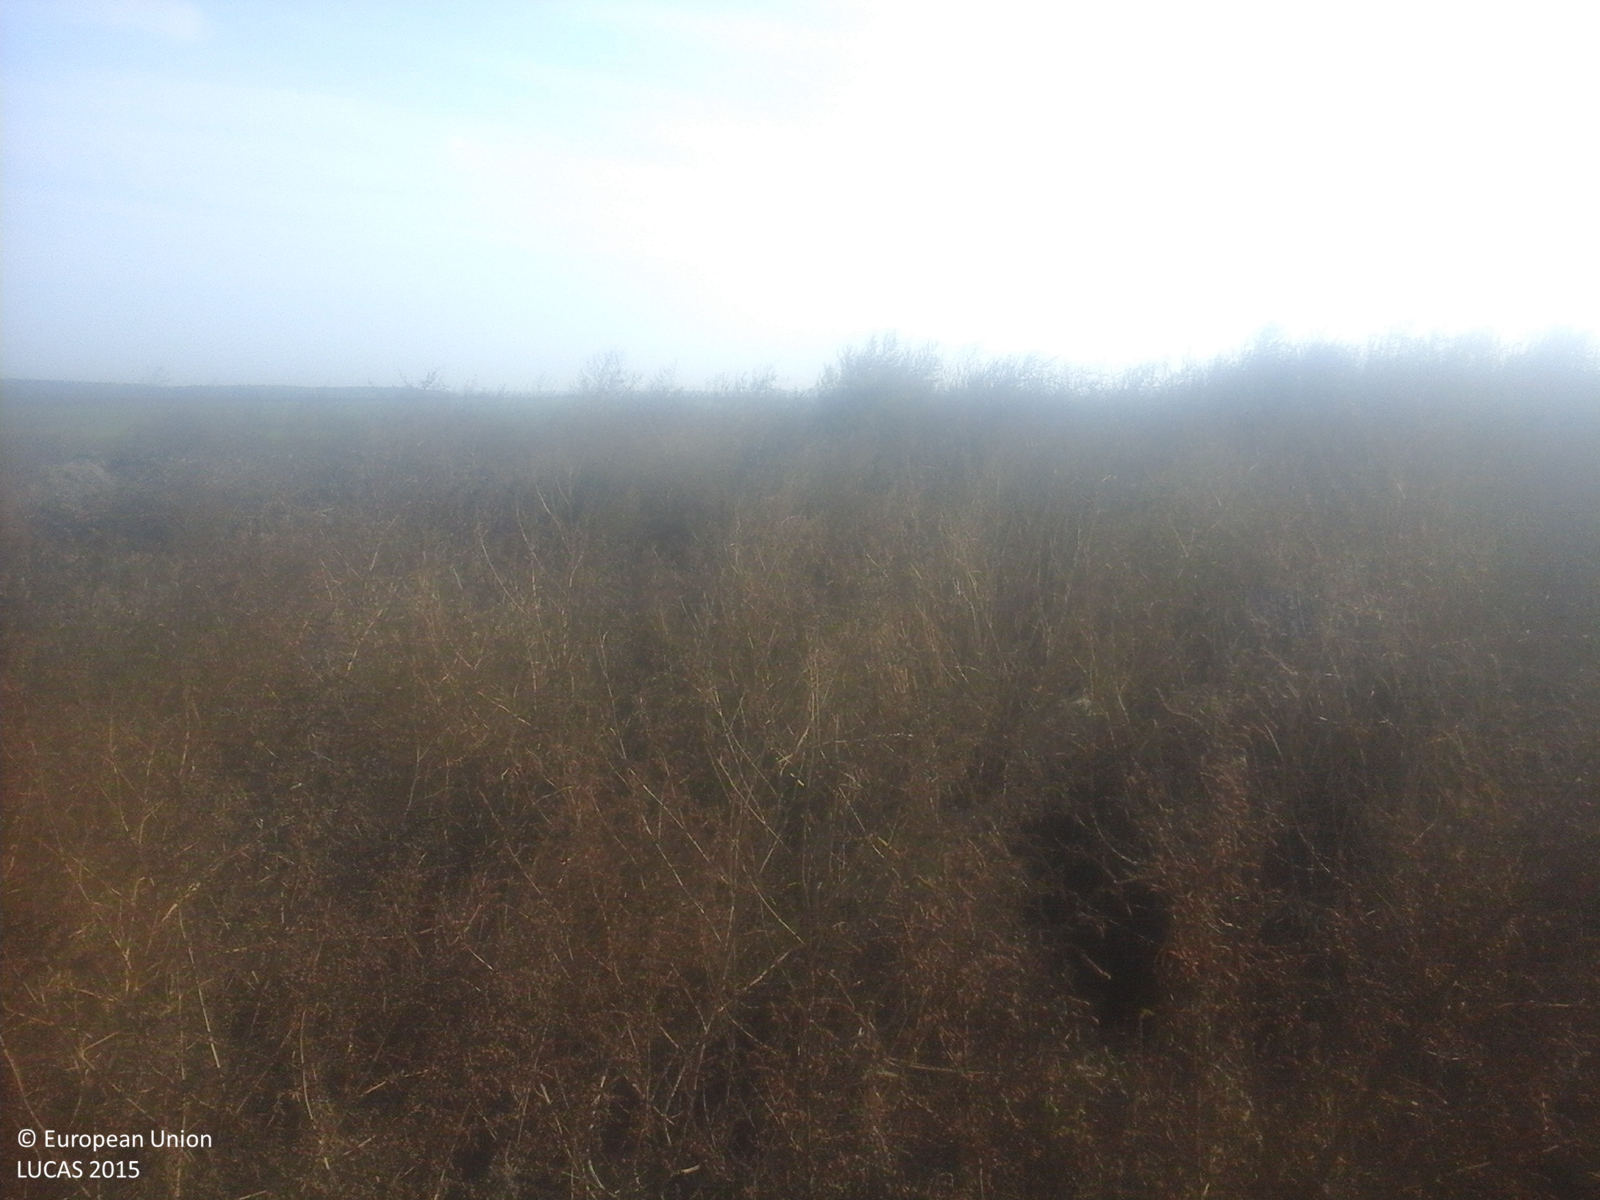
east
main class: Grassland
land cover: Spontaneously vegetated surfaces
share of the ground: > 75 %
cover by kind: herbaceous plants 100 %
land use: Agriculture (excluding fallow land and kitchen gardens)
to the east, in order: Spontaneously vegetated surfaces; Tracks; Common wheat; Other bare soil
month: October
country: RO
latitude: 45.4034
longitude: 27.0943
